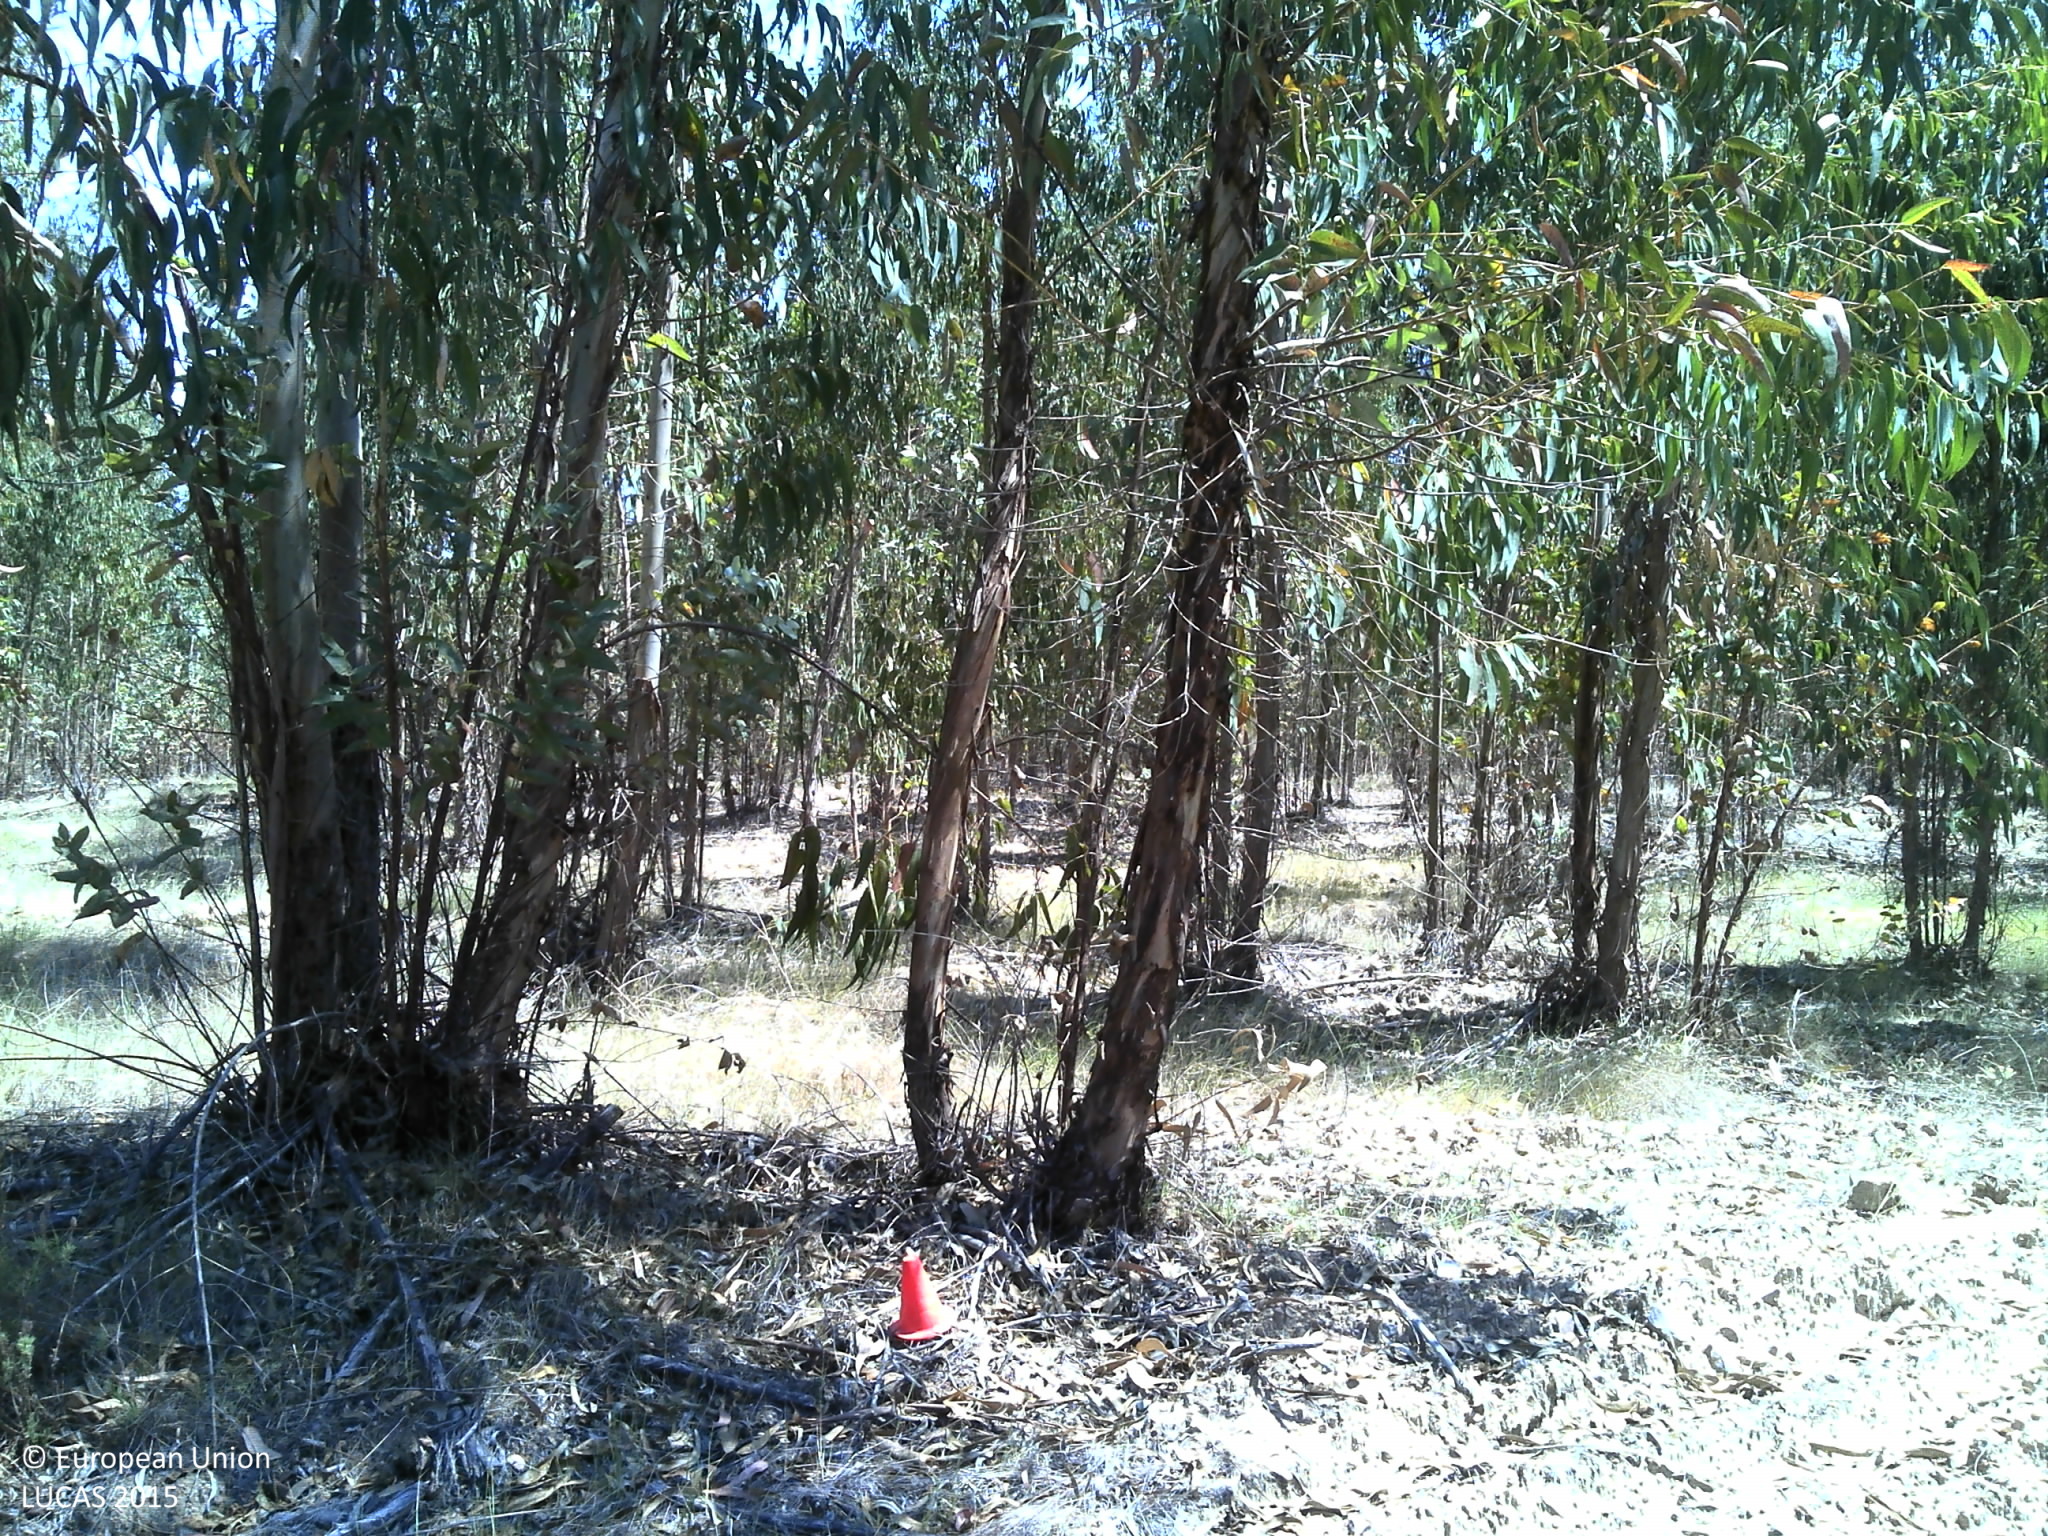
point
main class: Woodland
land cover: Broadleaved woodland
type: exotic forest
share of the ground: 50 - 75 %
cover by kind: broadleaved forest trees 50 %, unconsolidated bare surface 40 %, herbaceous plants 10 %
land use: Forestry
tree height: > 5 m
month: May
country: PT
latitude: 39.2580
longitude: -7.6733
